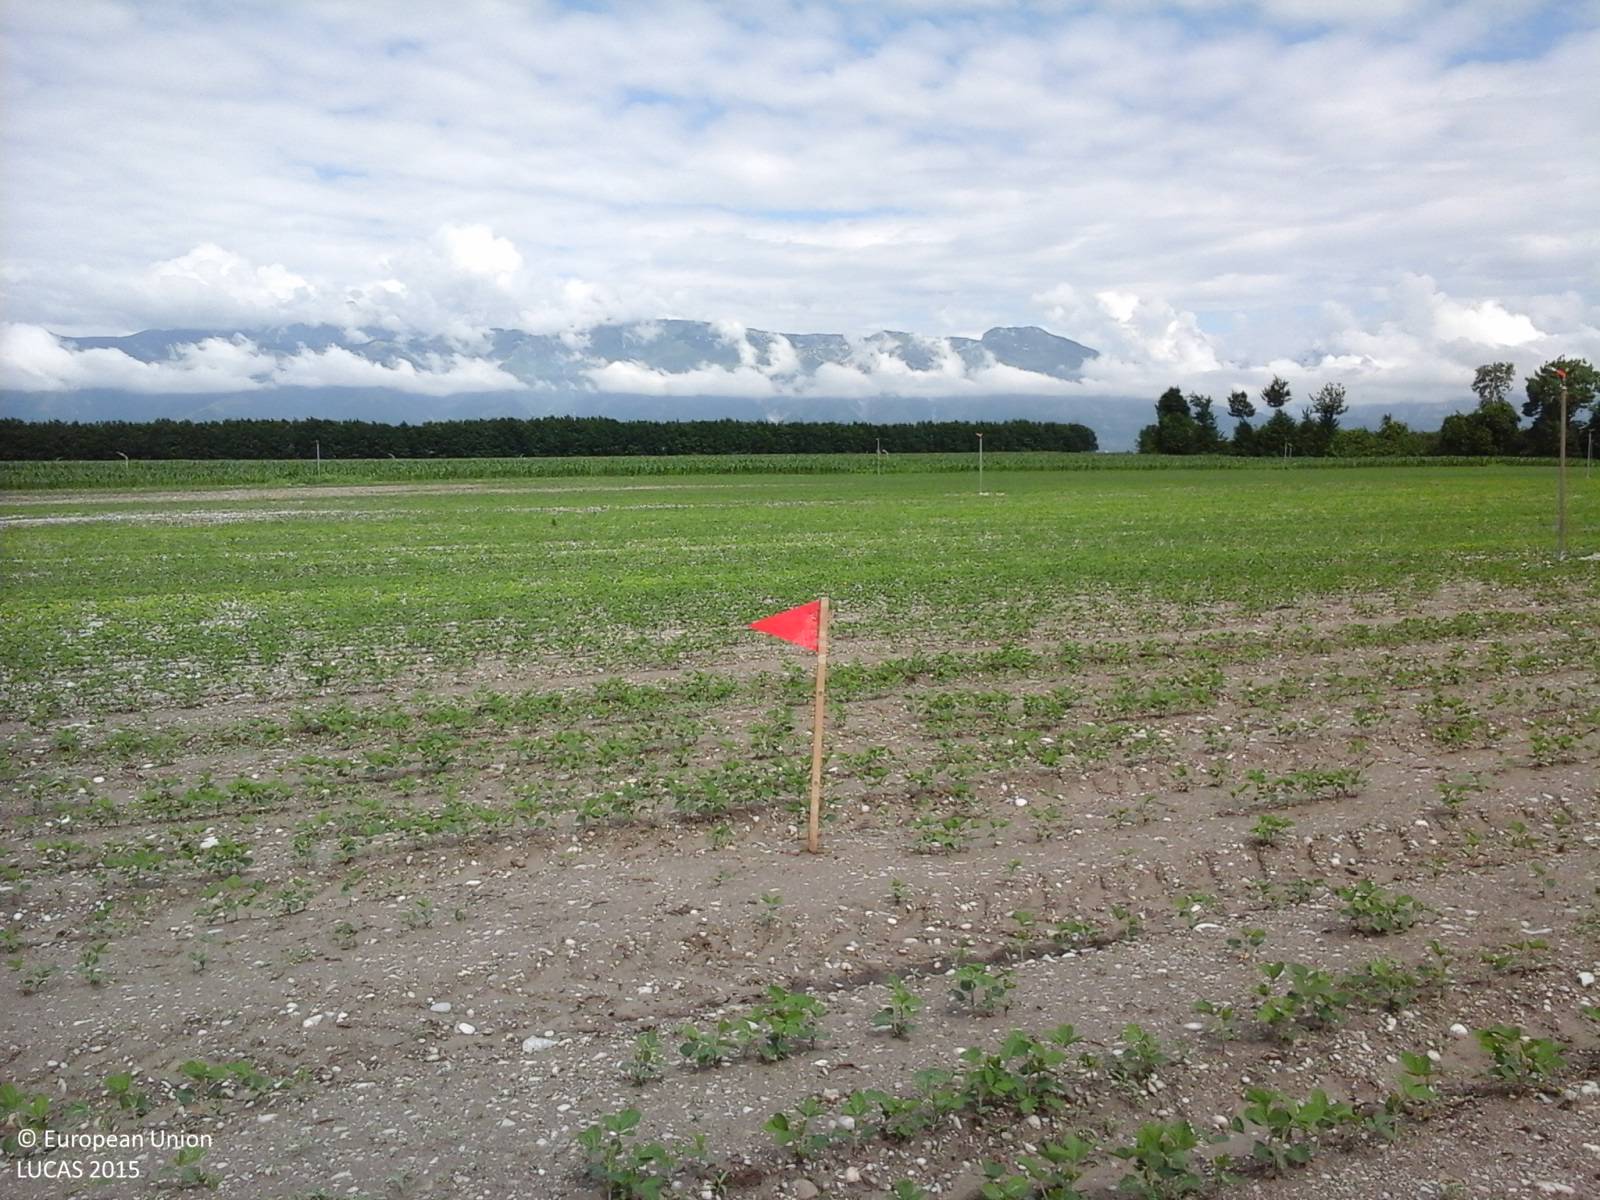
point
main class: Cropland
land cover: Soya
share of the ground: < 10 %
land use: Agriculture (excluding fallow land and kitchen gardens)
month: June
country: IT
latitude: 46.0642
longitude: 12.7244
